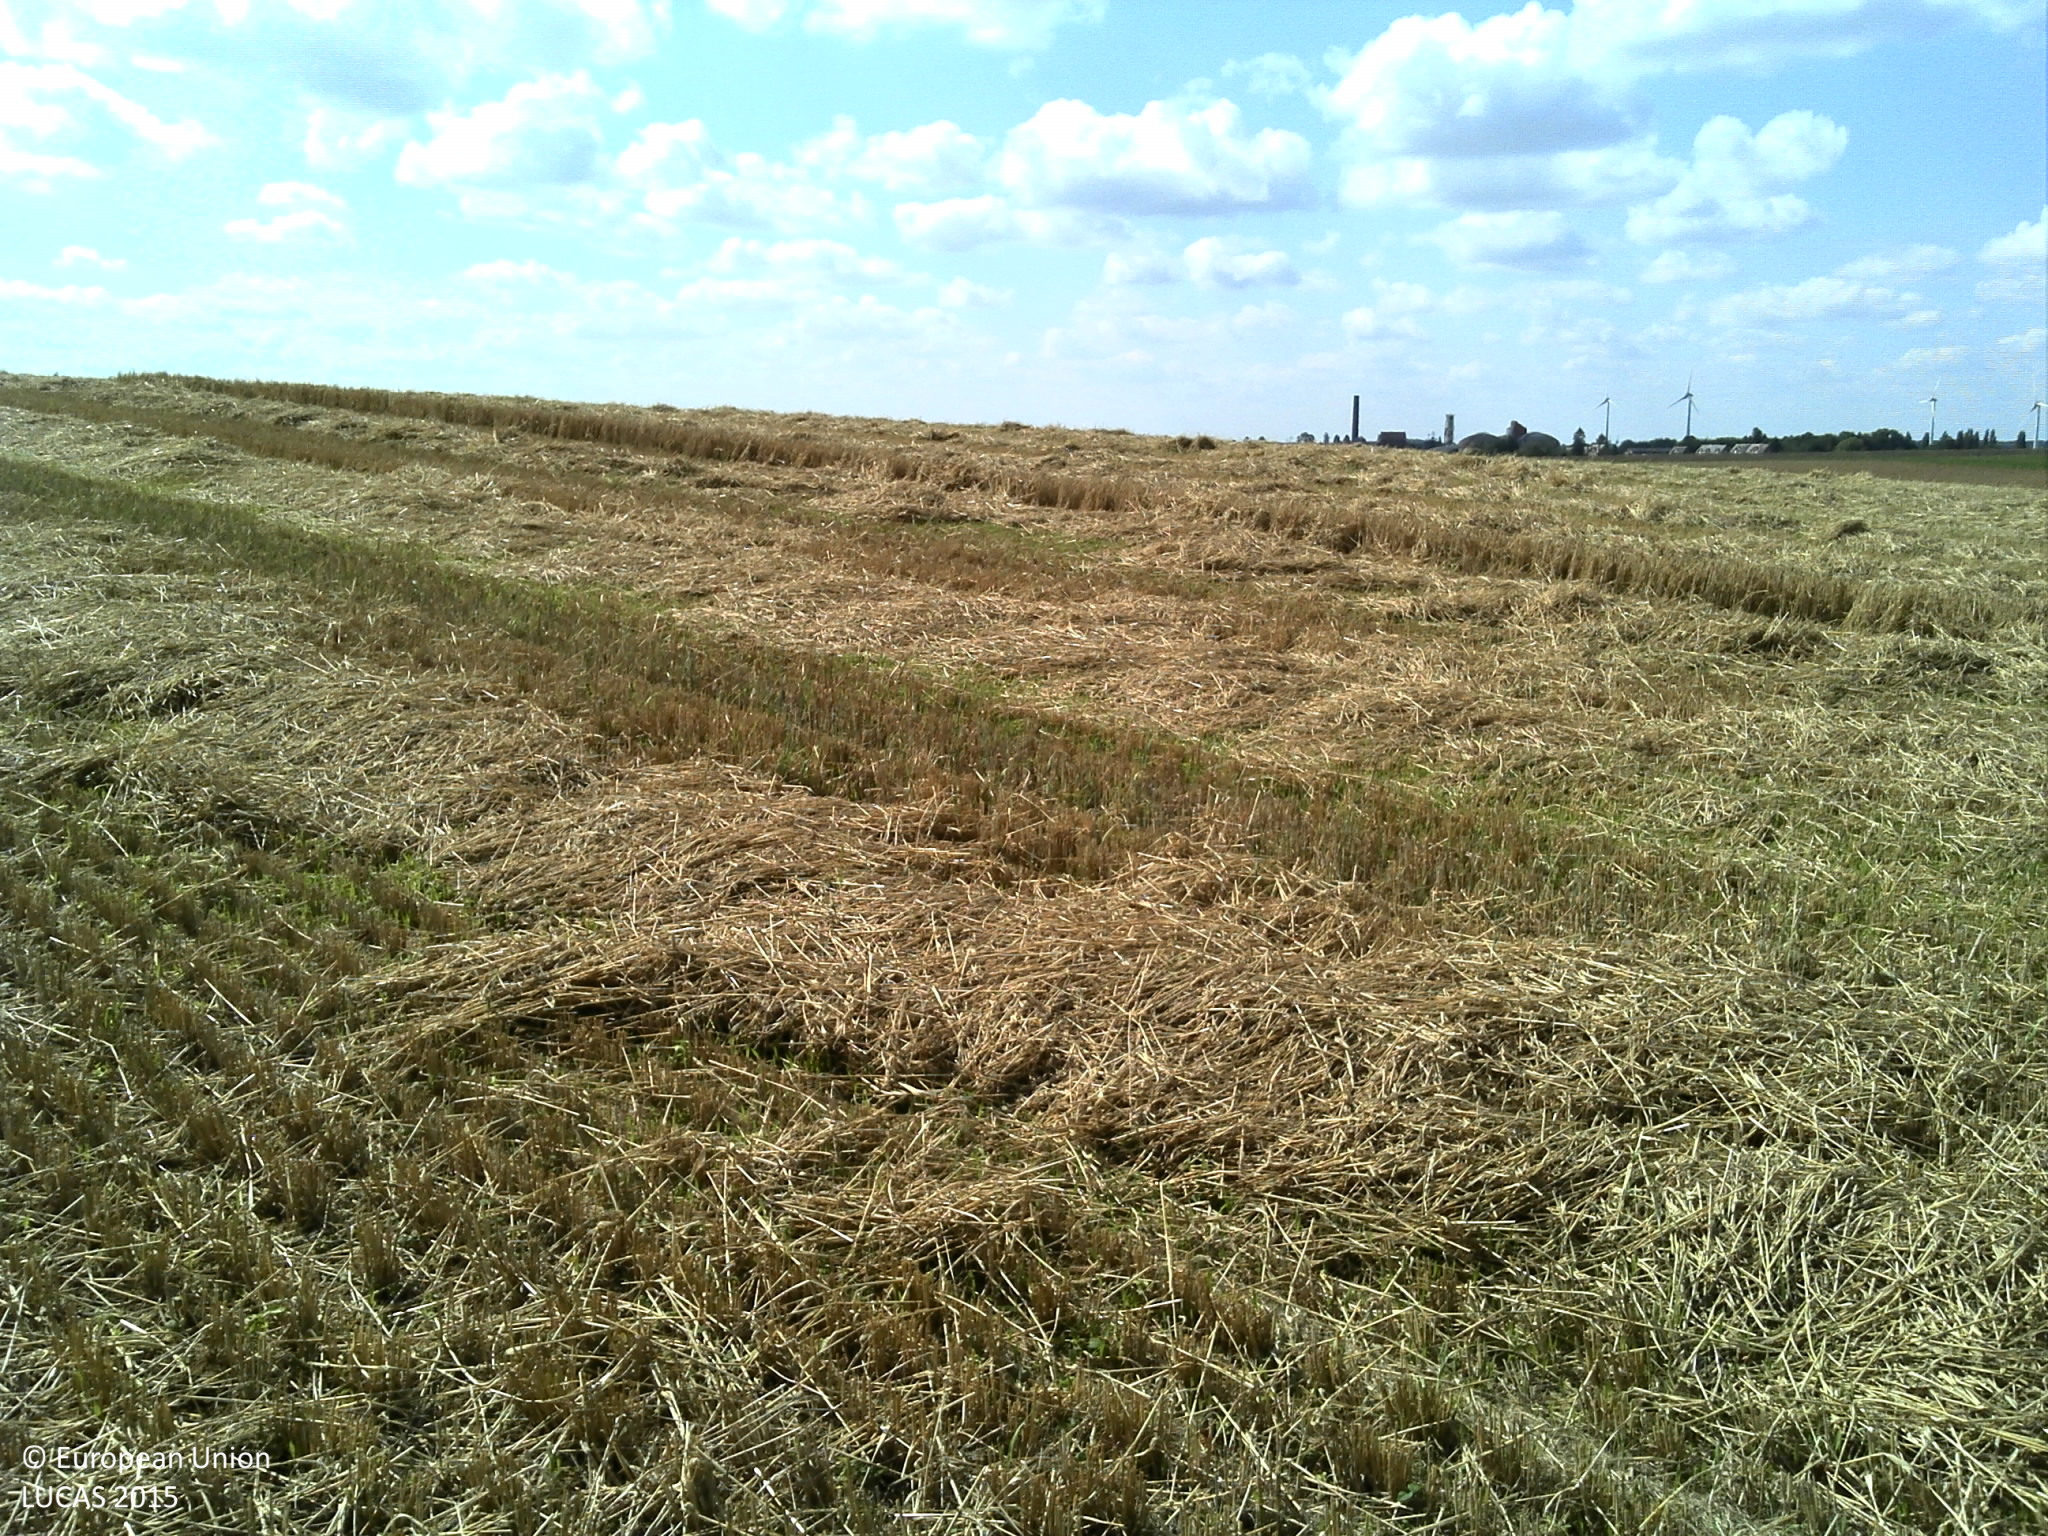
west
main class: Cropland
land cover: Barley
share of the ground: 10 - 25 %
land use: Agriculture (excluding fallow land and kitchen gardens)
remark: Harvested field
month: August
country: FR
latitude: 49.9778
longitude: 3.1441
